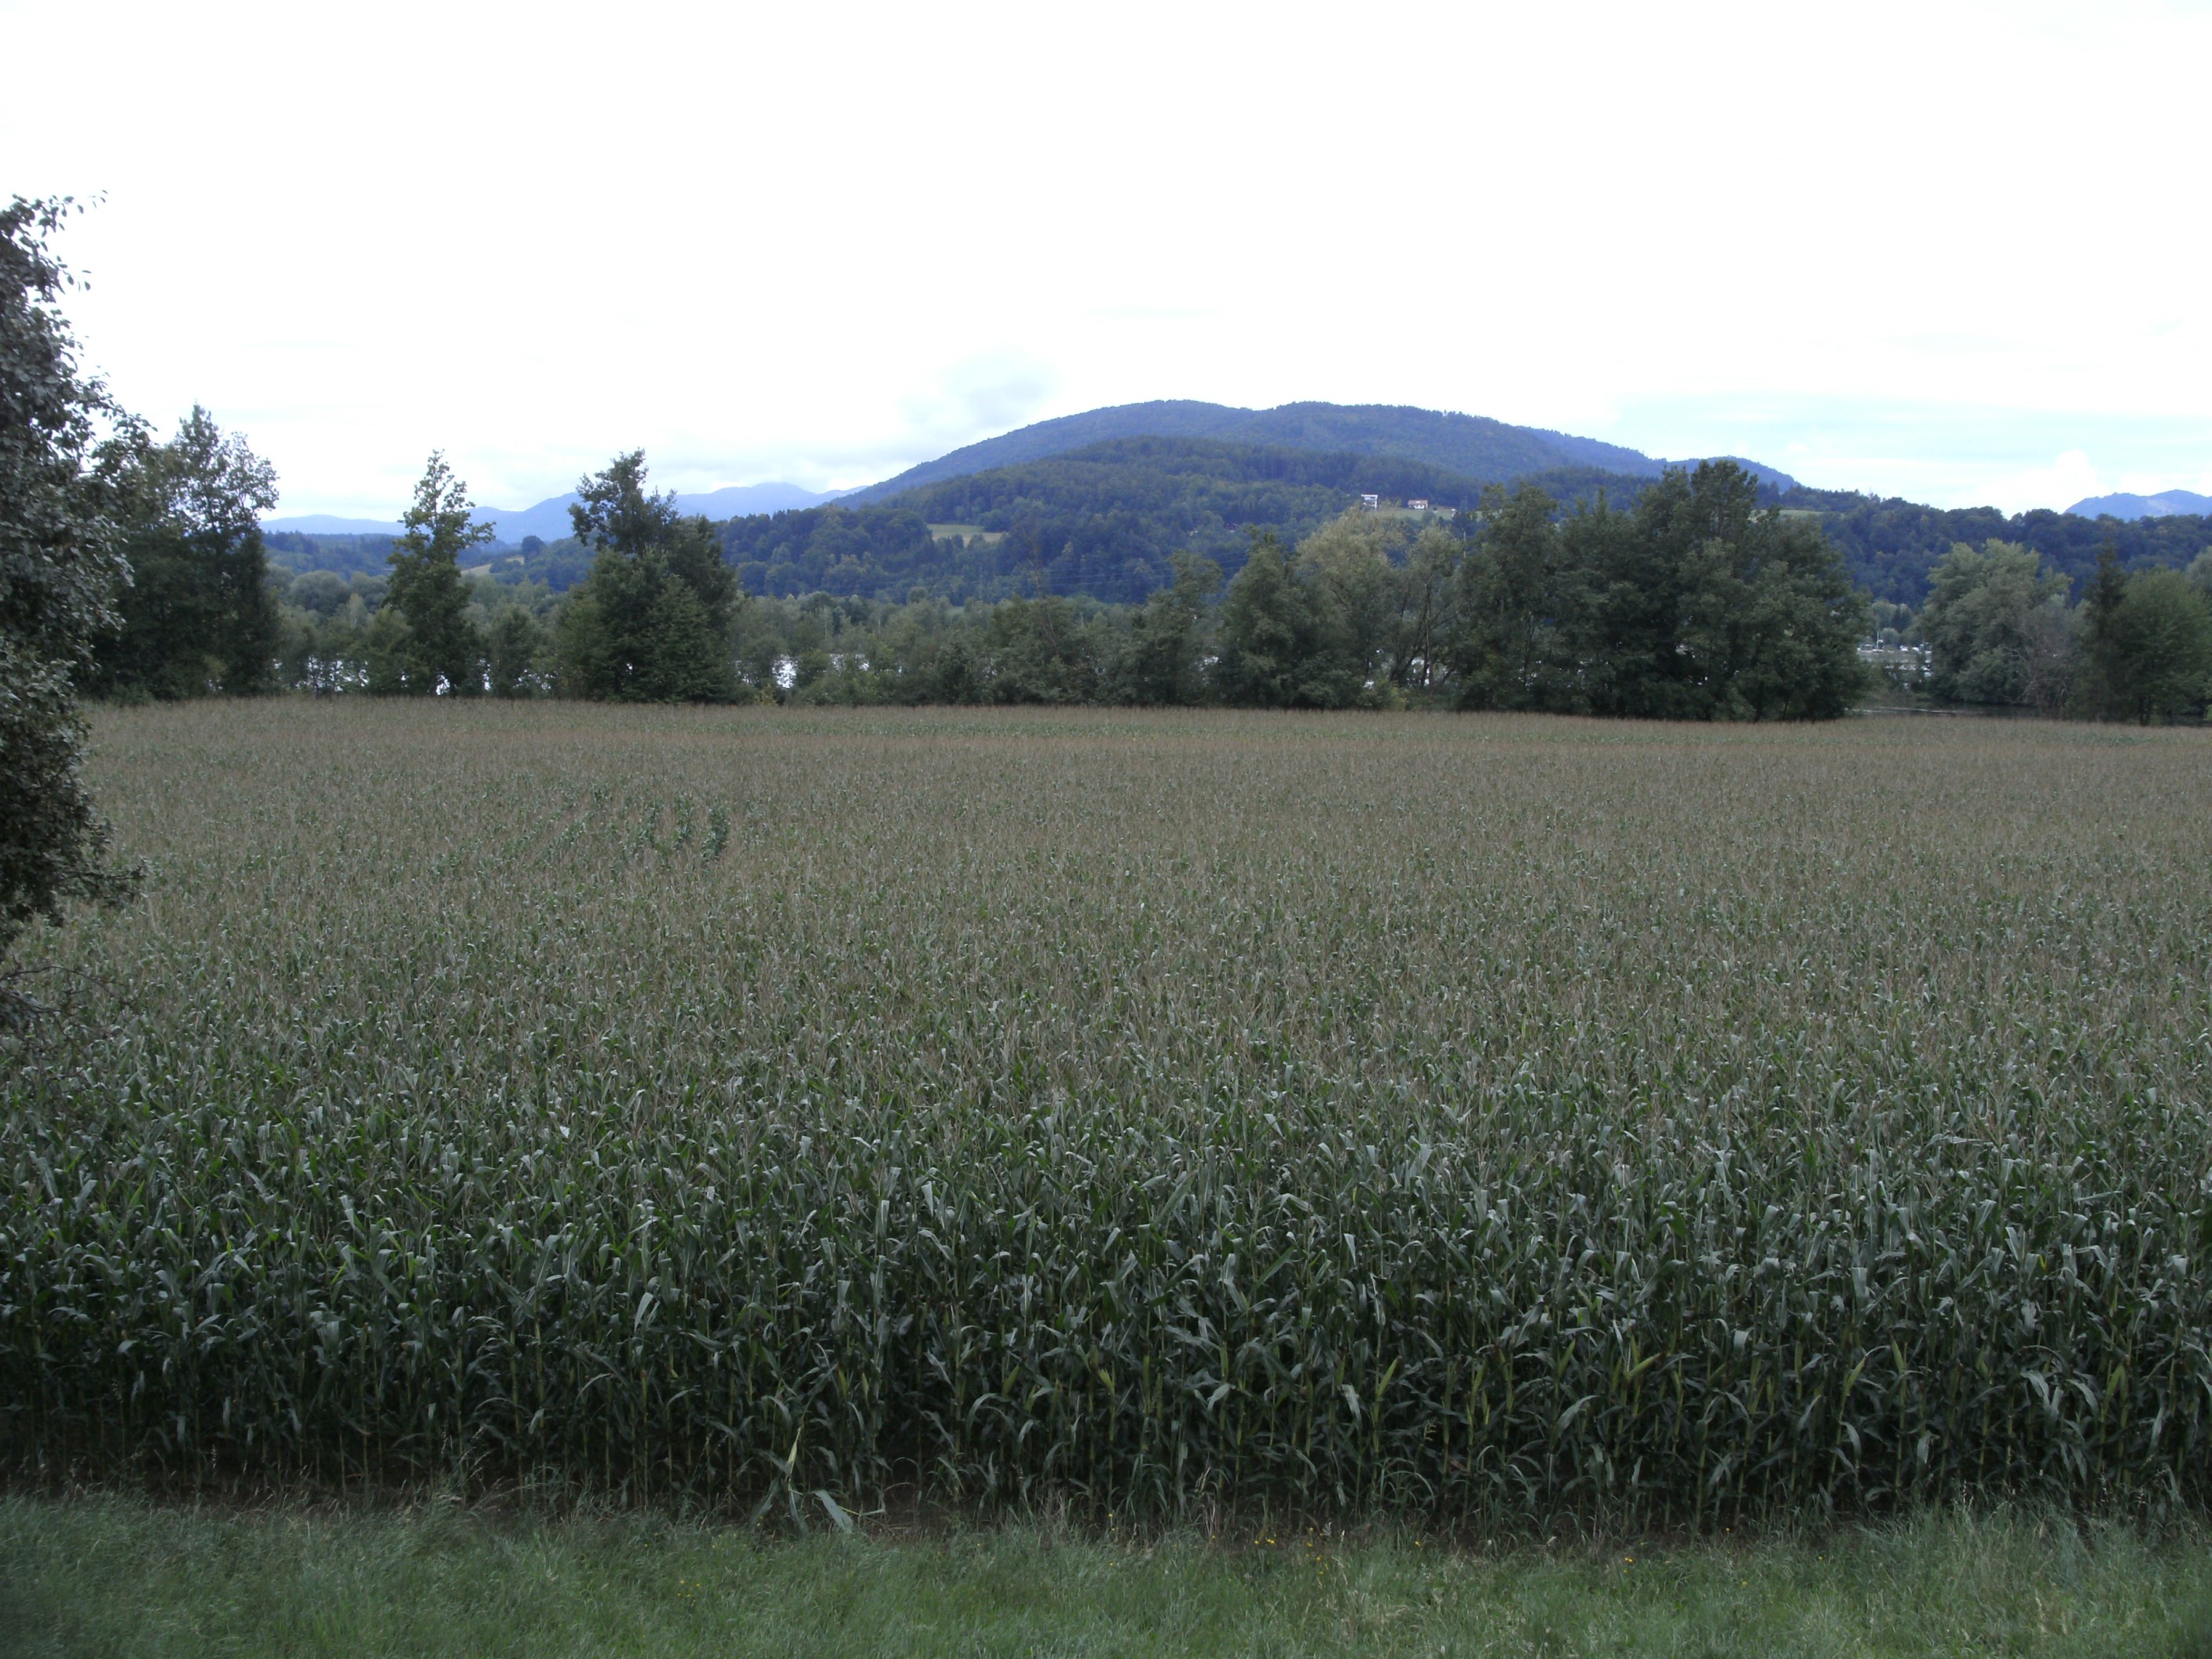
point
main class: Cropland
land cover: Maize
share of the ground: > 75 %
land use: Agriculture (excluding fallow land and kitchen gardens)
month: July
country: AT
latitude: 46.6319
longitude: 14.5824
